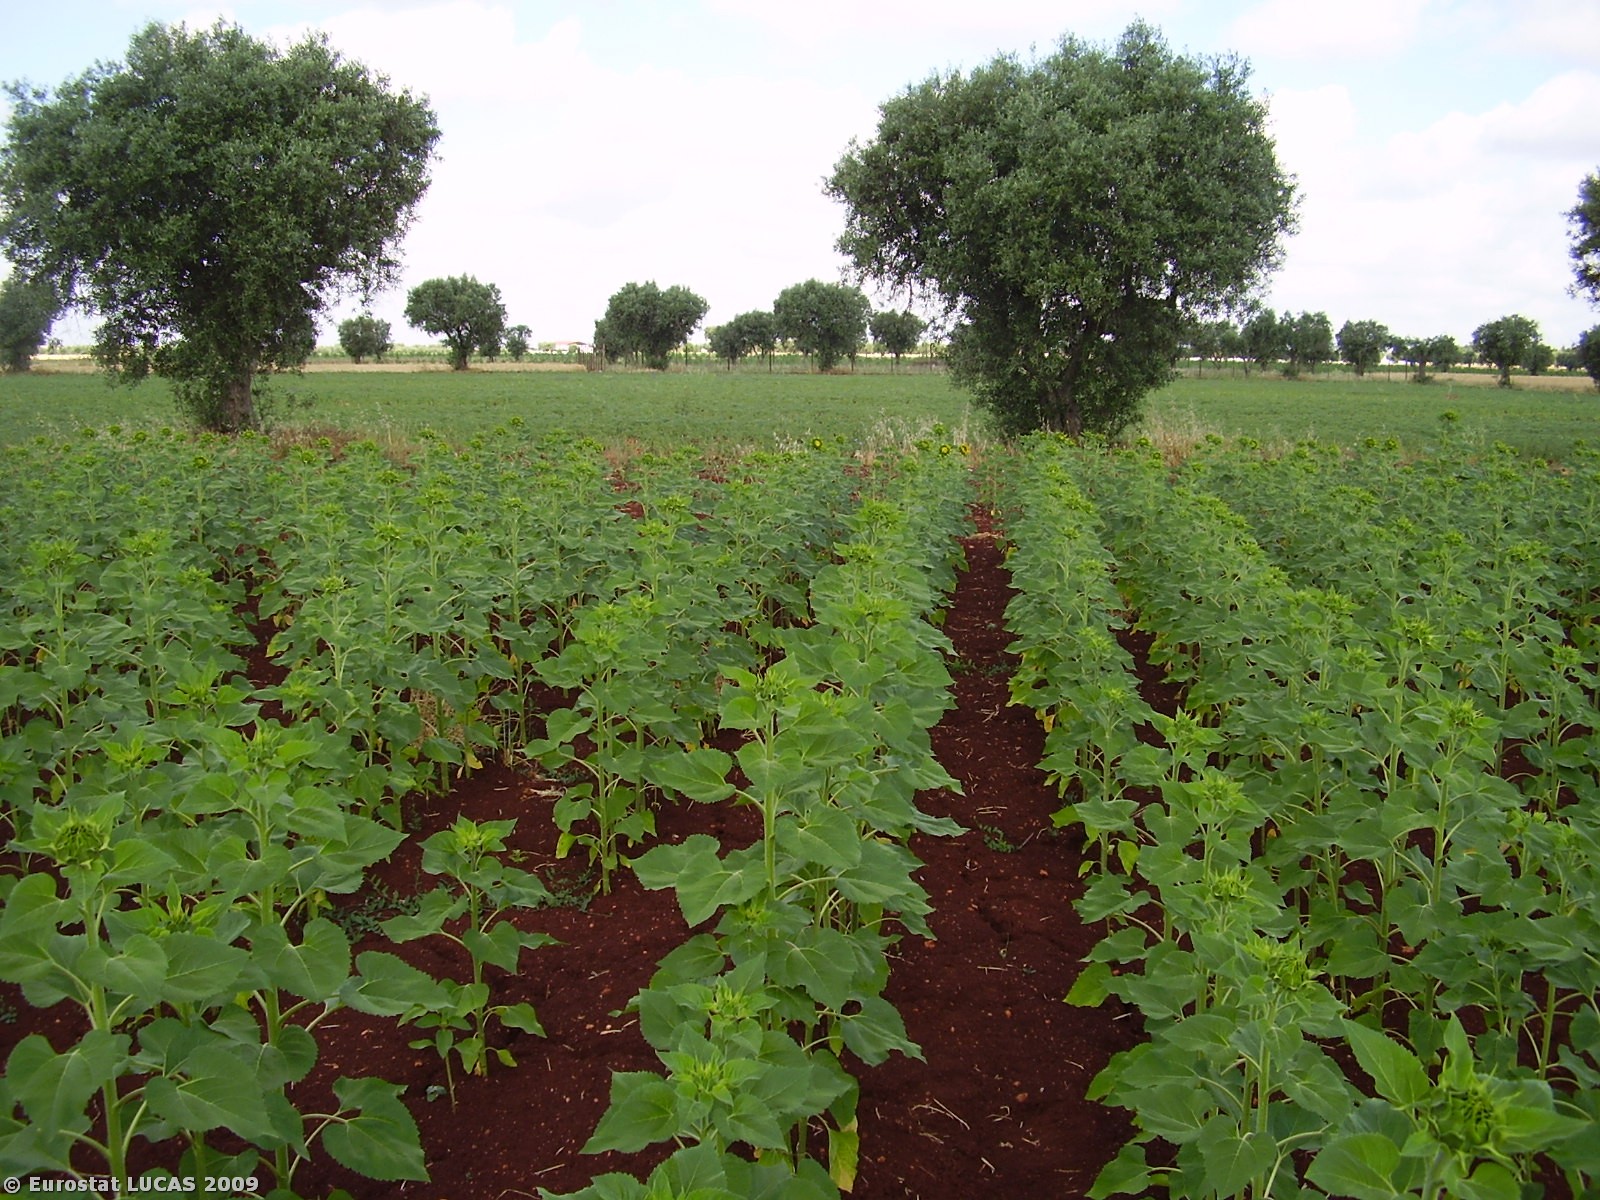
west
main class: Cropland
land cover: Sunflower
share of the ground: 50 - 75 %
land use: Agriculture (excluding fallow land and kitchen gardens)
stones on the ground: < 10 %
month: May
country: PT
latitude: 37.9298
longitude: -7.7605
